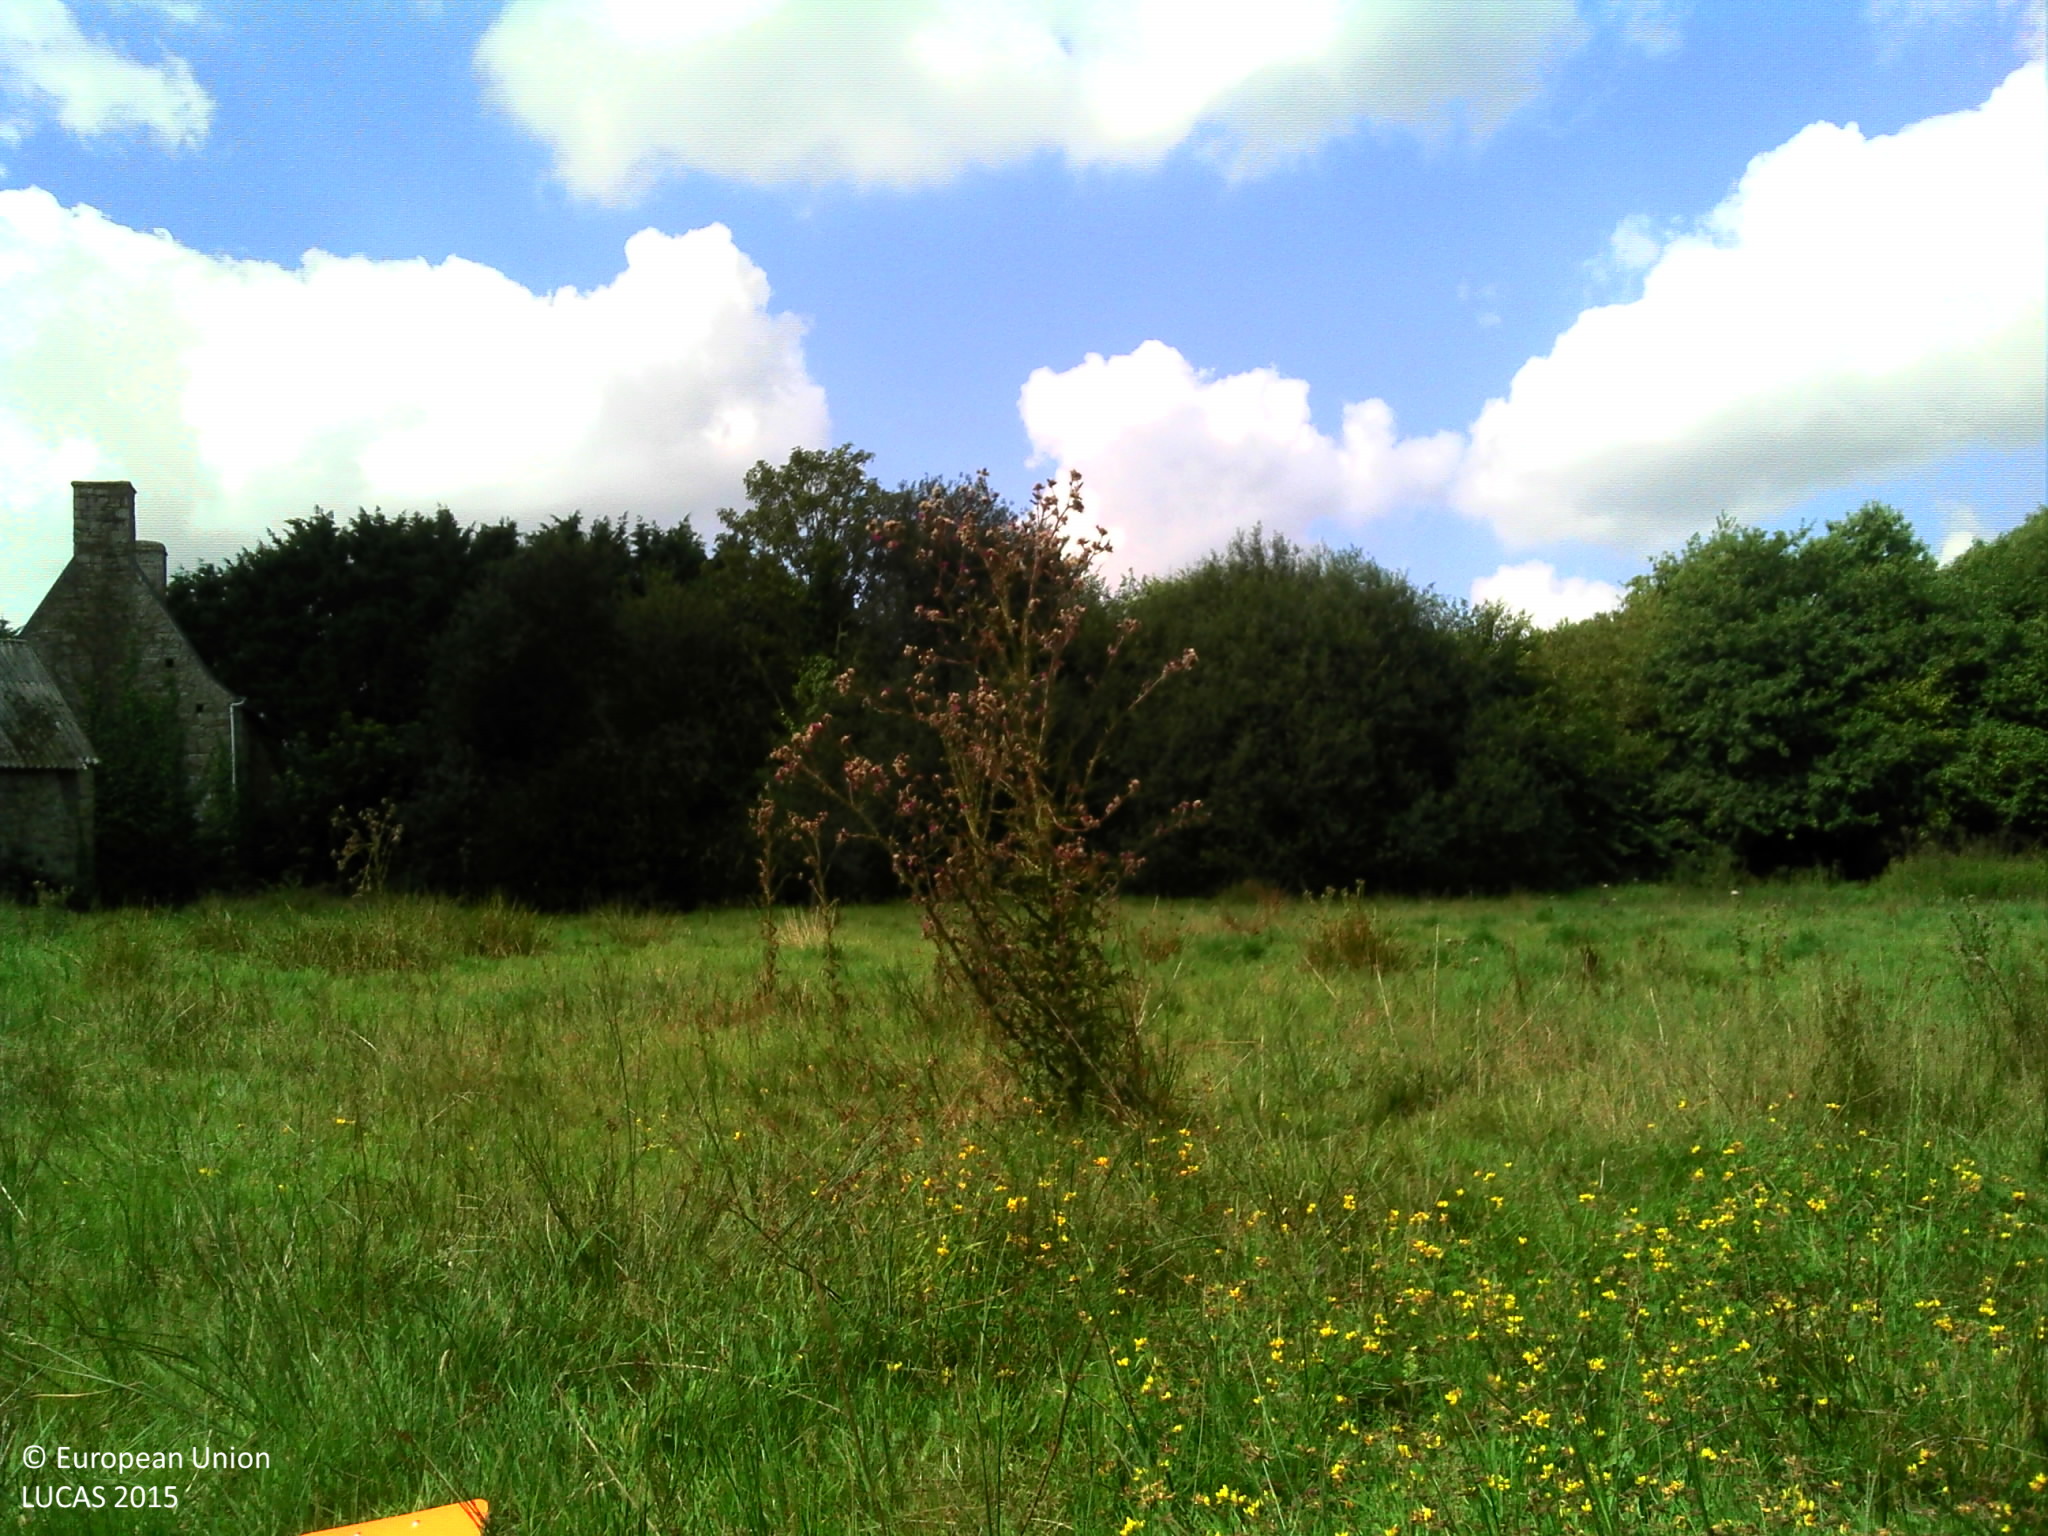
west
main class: Grassland
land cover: Grassland without tree/shrub cover
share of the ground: > 75 %
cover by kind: herbaceous plants 100 %
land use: Agriculture (excluding fallow land and kitchen gardens)
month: August
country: FR
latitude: 48.5941
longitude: -3.1850
